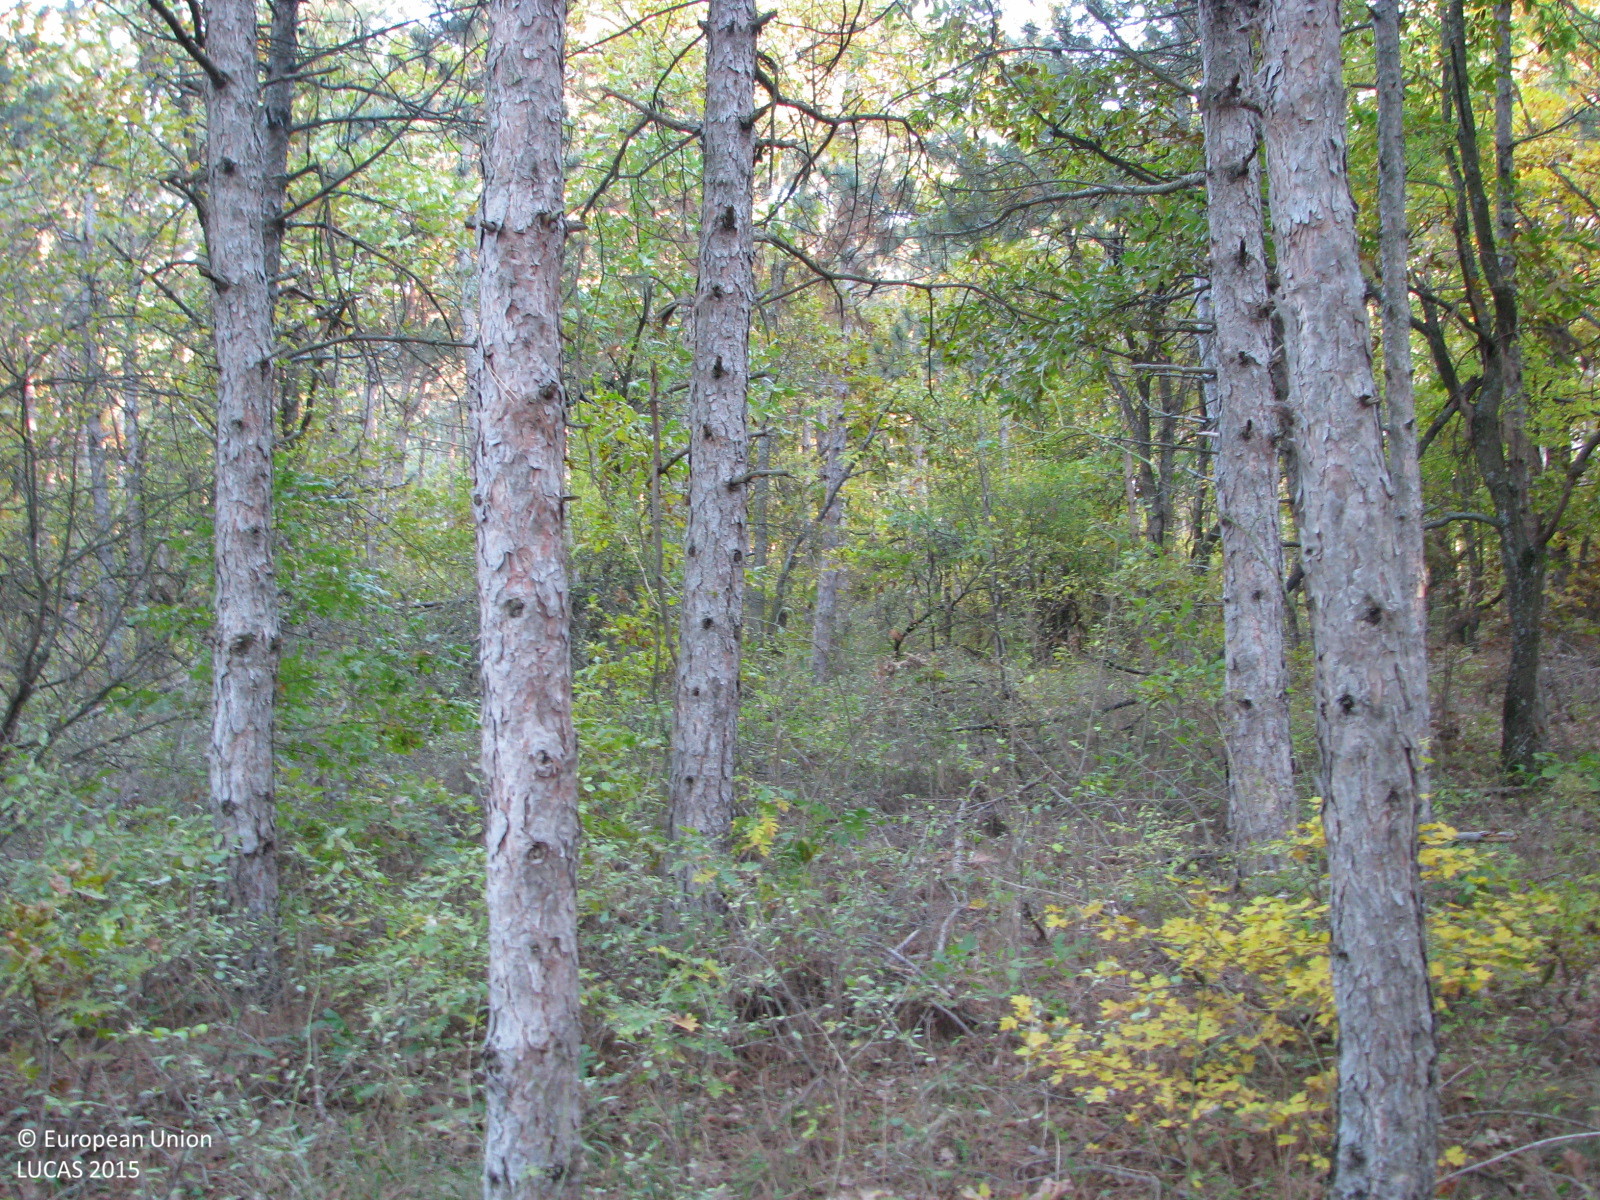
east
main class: Woodland
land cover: Pine dominated mixed woodland
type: hemiboreal forest and nemoral coniferous forest and mixed broadleaved-coniferous forest
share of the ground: > 75 %
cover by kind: coniferous forest trees 60 %, broadleaved forest trees 25 %, herbaceous plants 10 %, shrubs 5 %
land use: Forestry
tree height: > 5 m
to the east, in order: Pine dominated mixed woodland; Grassland with sparse tree/shrub cover; Tracks; Grassland with sparse tree/shrub cover; Groves; Grassland with sparse tree/shrub cover; Tracks; Grassland with sparse tree/shrub cover
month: November
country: BG
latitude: 42.1417
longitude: 26.9038
